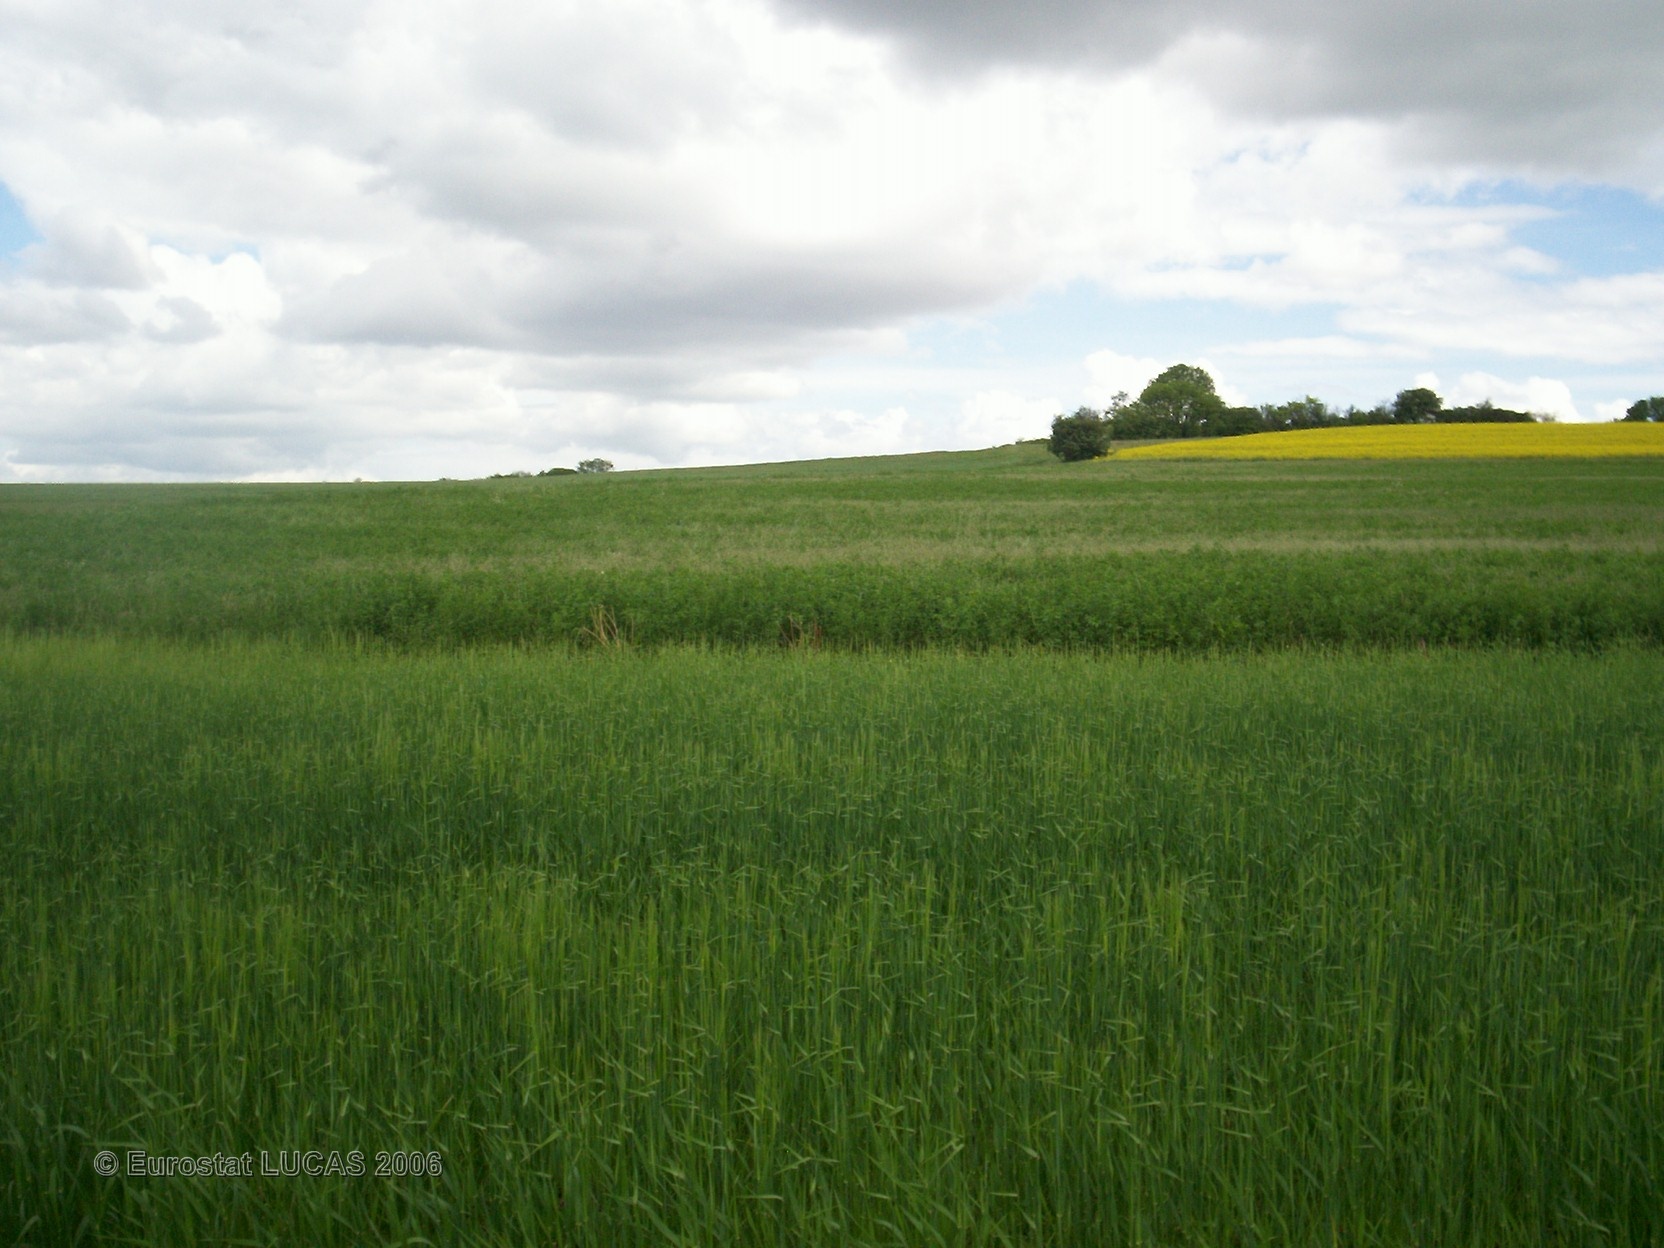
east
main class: Cropland
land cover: Barley
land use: Agriculture (excluding fallow land and kitchen gardens)
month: May
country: FR
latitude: 46.9740
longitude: 4.6243
